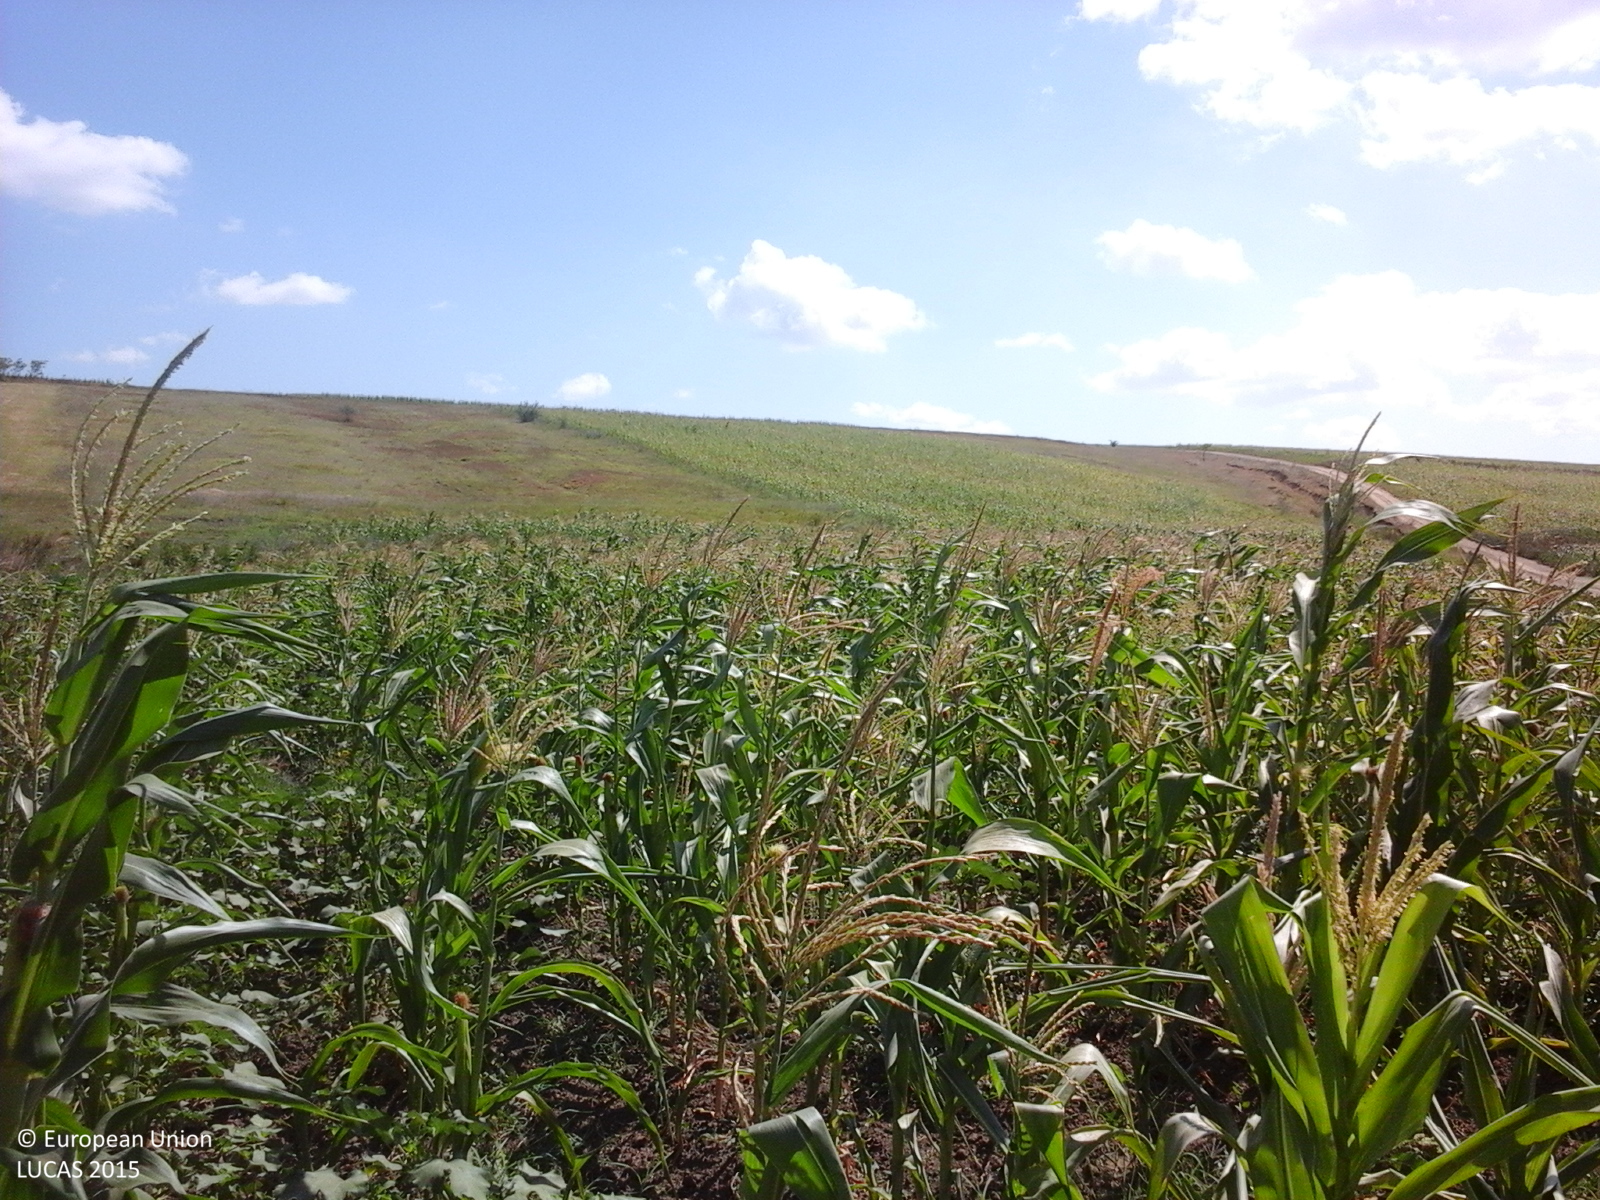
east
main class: Cropland
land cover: Maize
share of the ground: > 75 %
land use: Agriculture (excluding fallow land and kitchen gardens)
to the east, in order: Maize; Common wheat; Maize
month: July
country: RO
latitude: 46.3529
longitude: 27.9129
